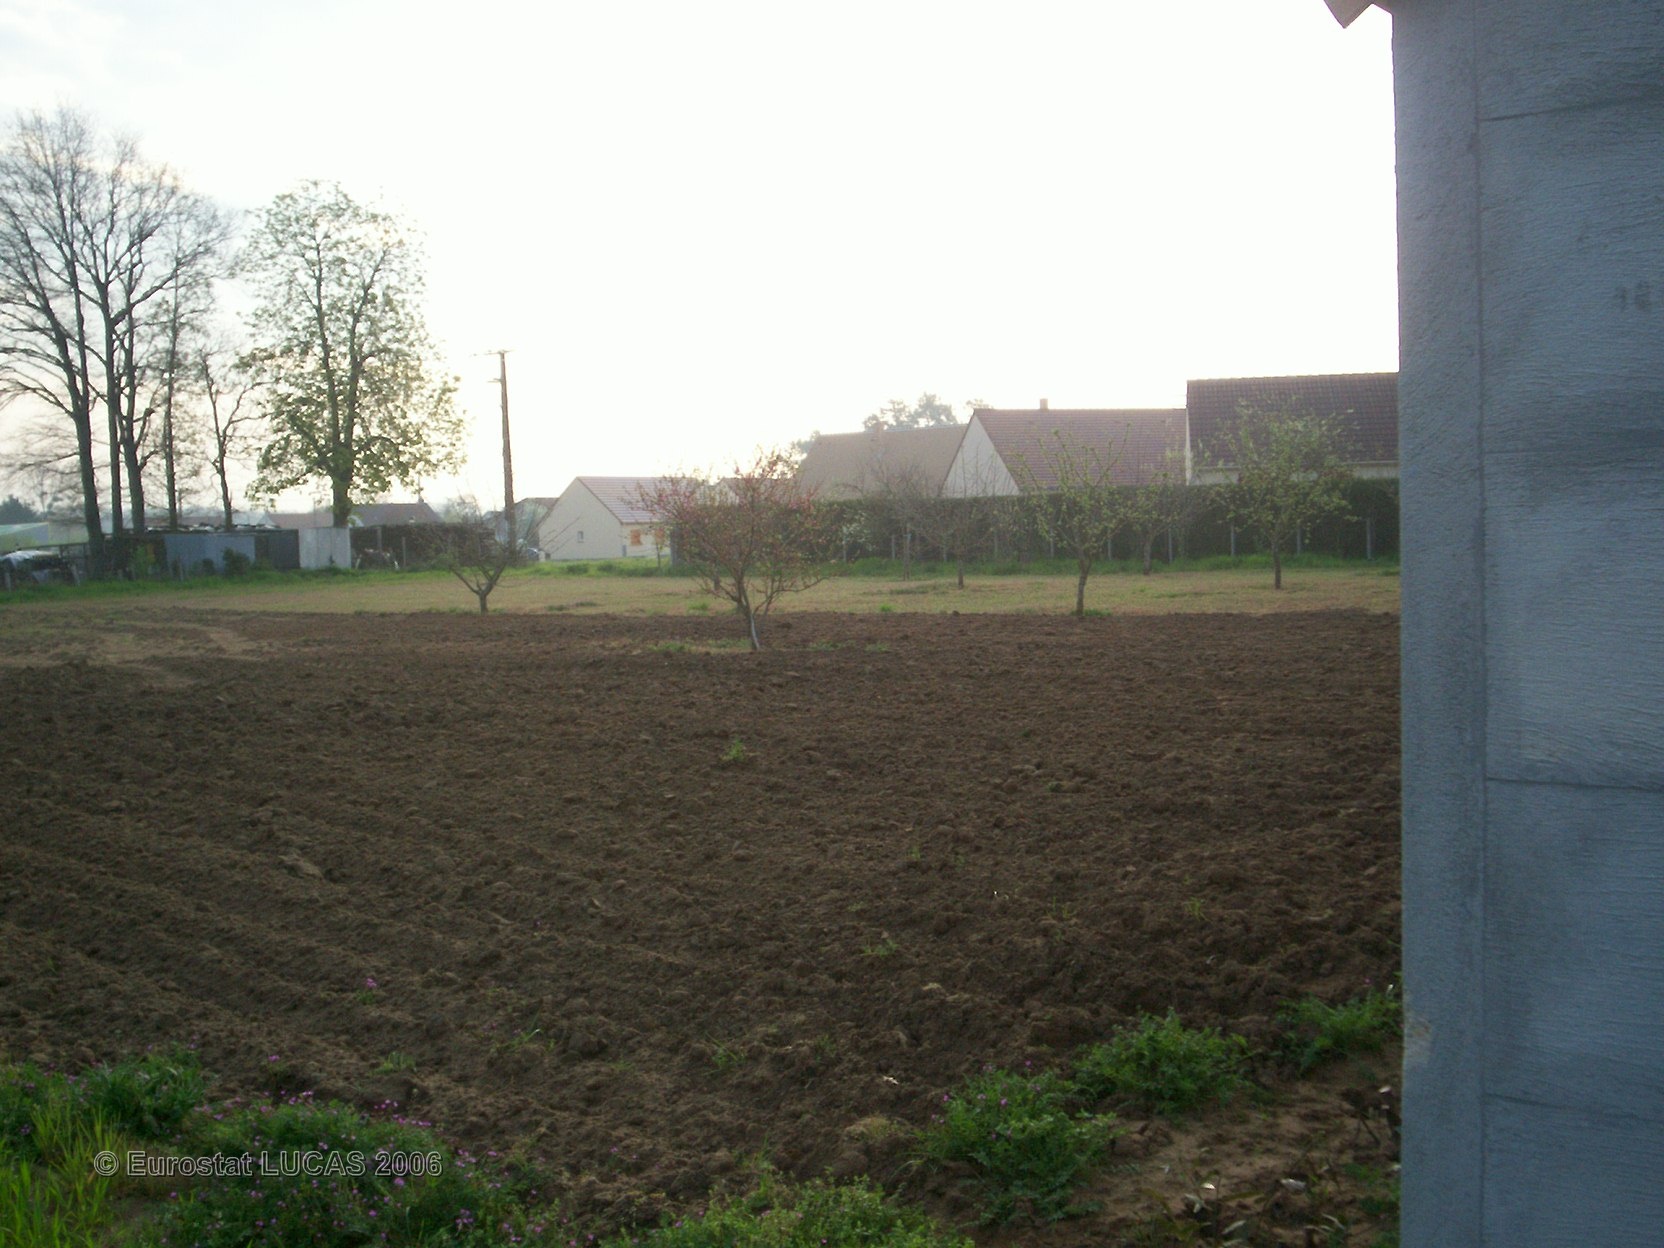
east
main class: Cropland
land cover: Common wheat
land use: Agriculture (excluding fallow land and kitchen gardens)
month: April
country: FR
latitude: 48.1449
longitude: 0.3653
